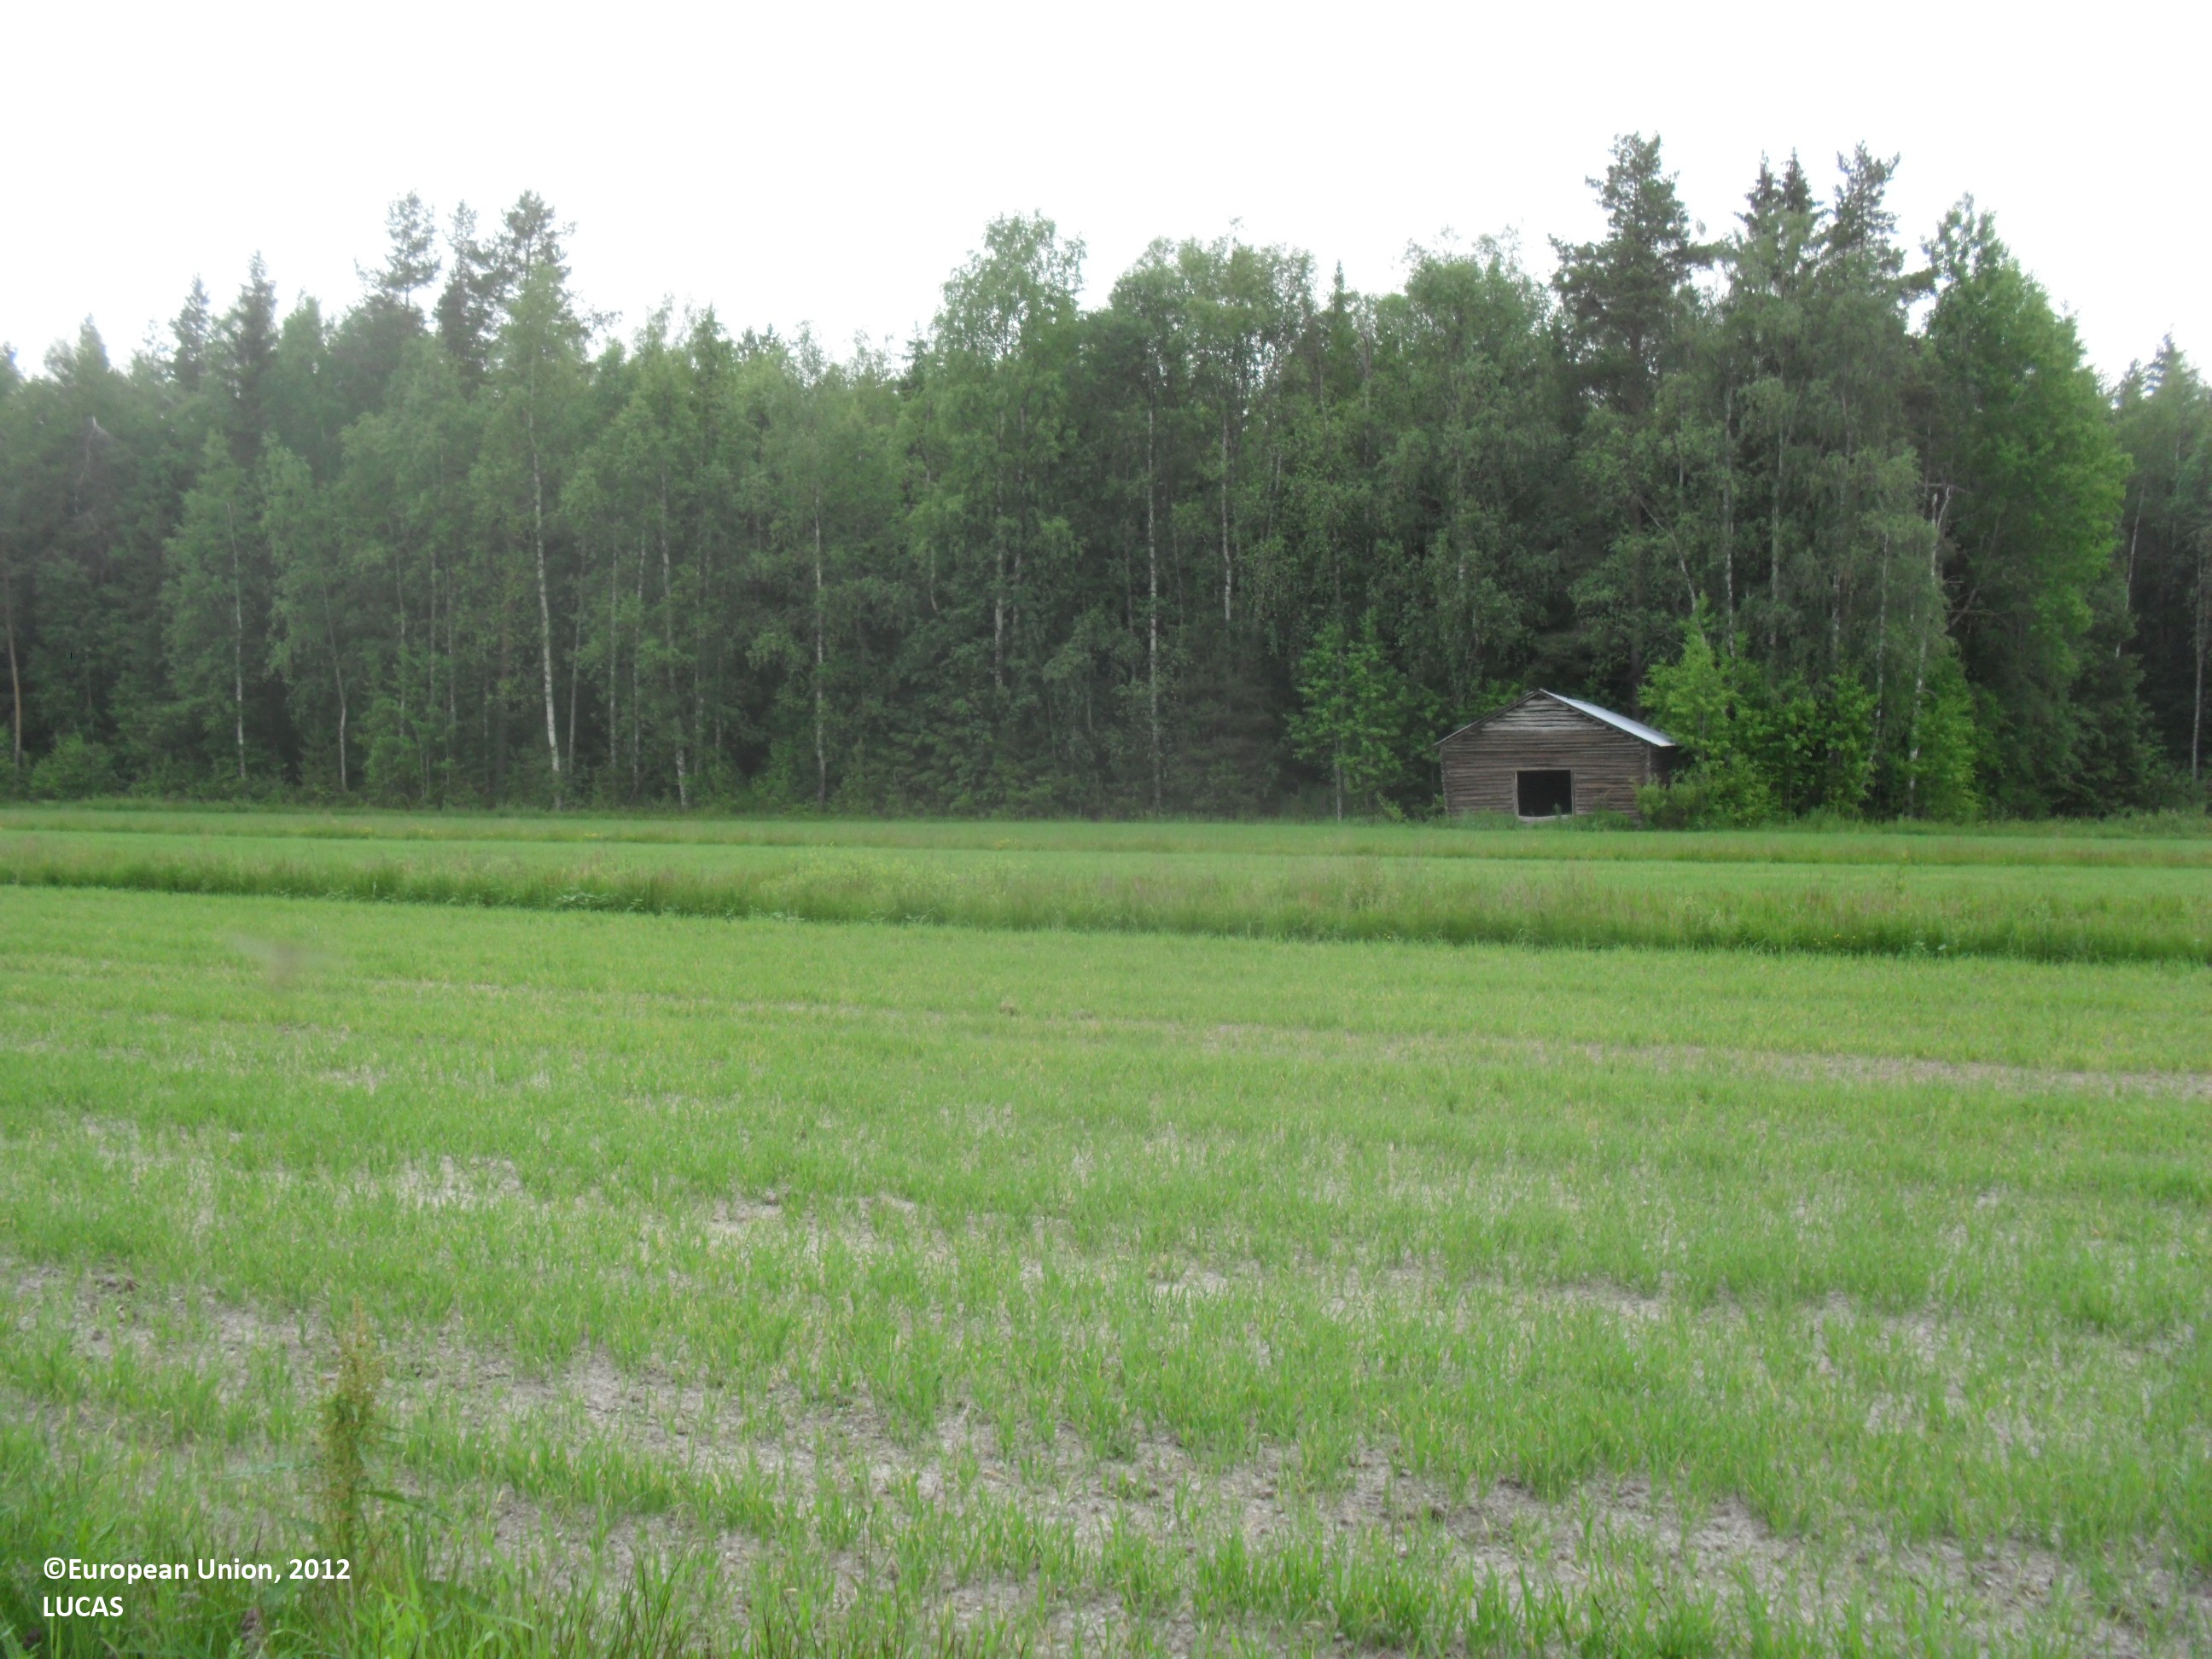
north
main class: Cropland
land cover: Barley
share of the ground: 10 - 25 %
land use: Agriculture (excluding fallow land and kitchen gardens)
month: June
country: FI
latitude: 63.4898
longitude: 23.0472
